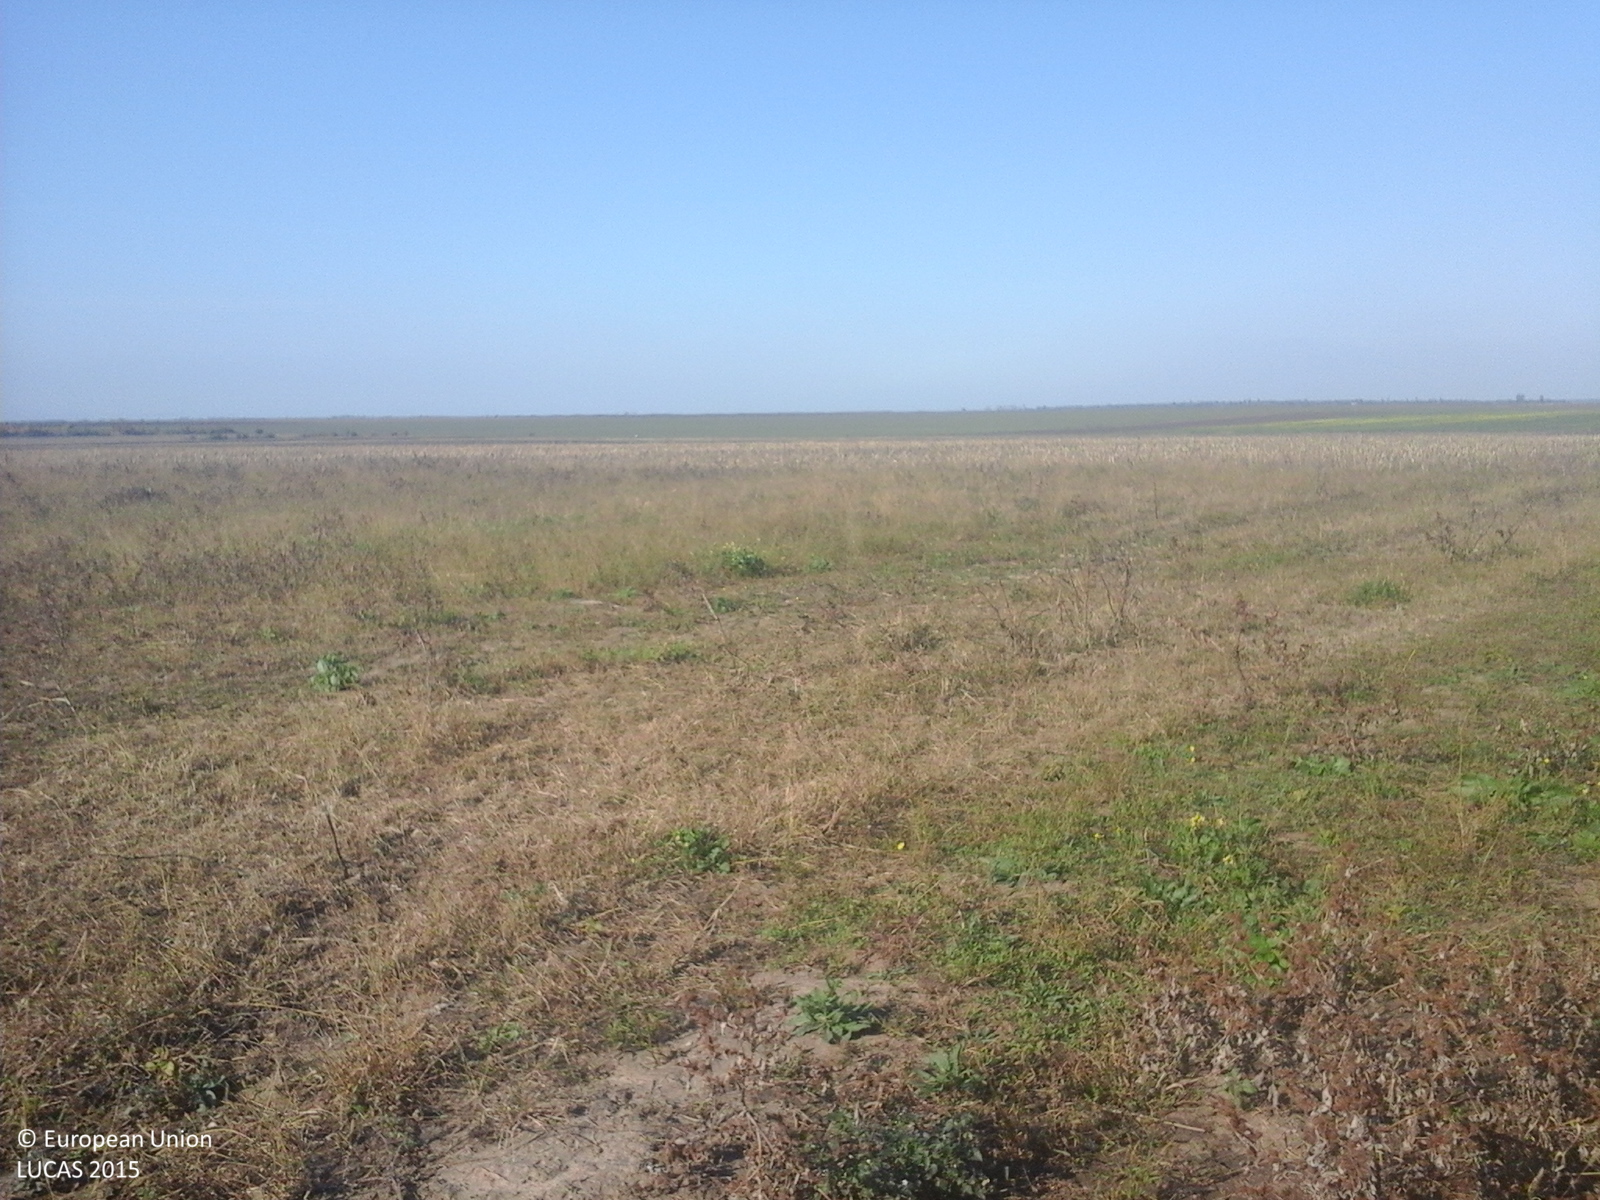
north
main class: Grassland
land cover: Spontaneously vegetated surfaces
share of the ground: > 75 %
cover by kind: herbaceous plants 100 %
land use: Fallow land
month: October
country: RO
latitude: 45.2489
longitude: 27.3602
